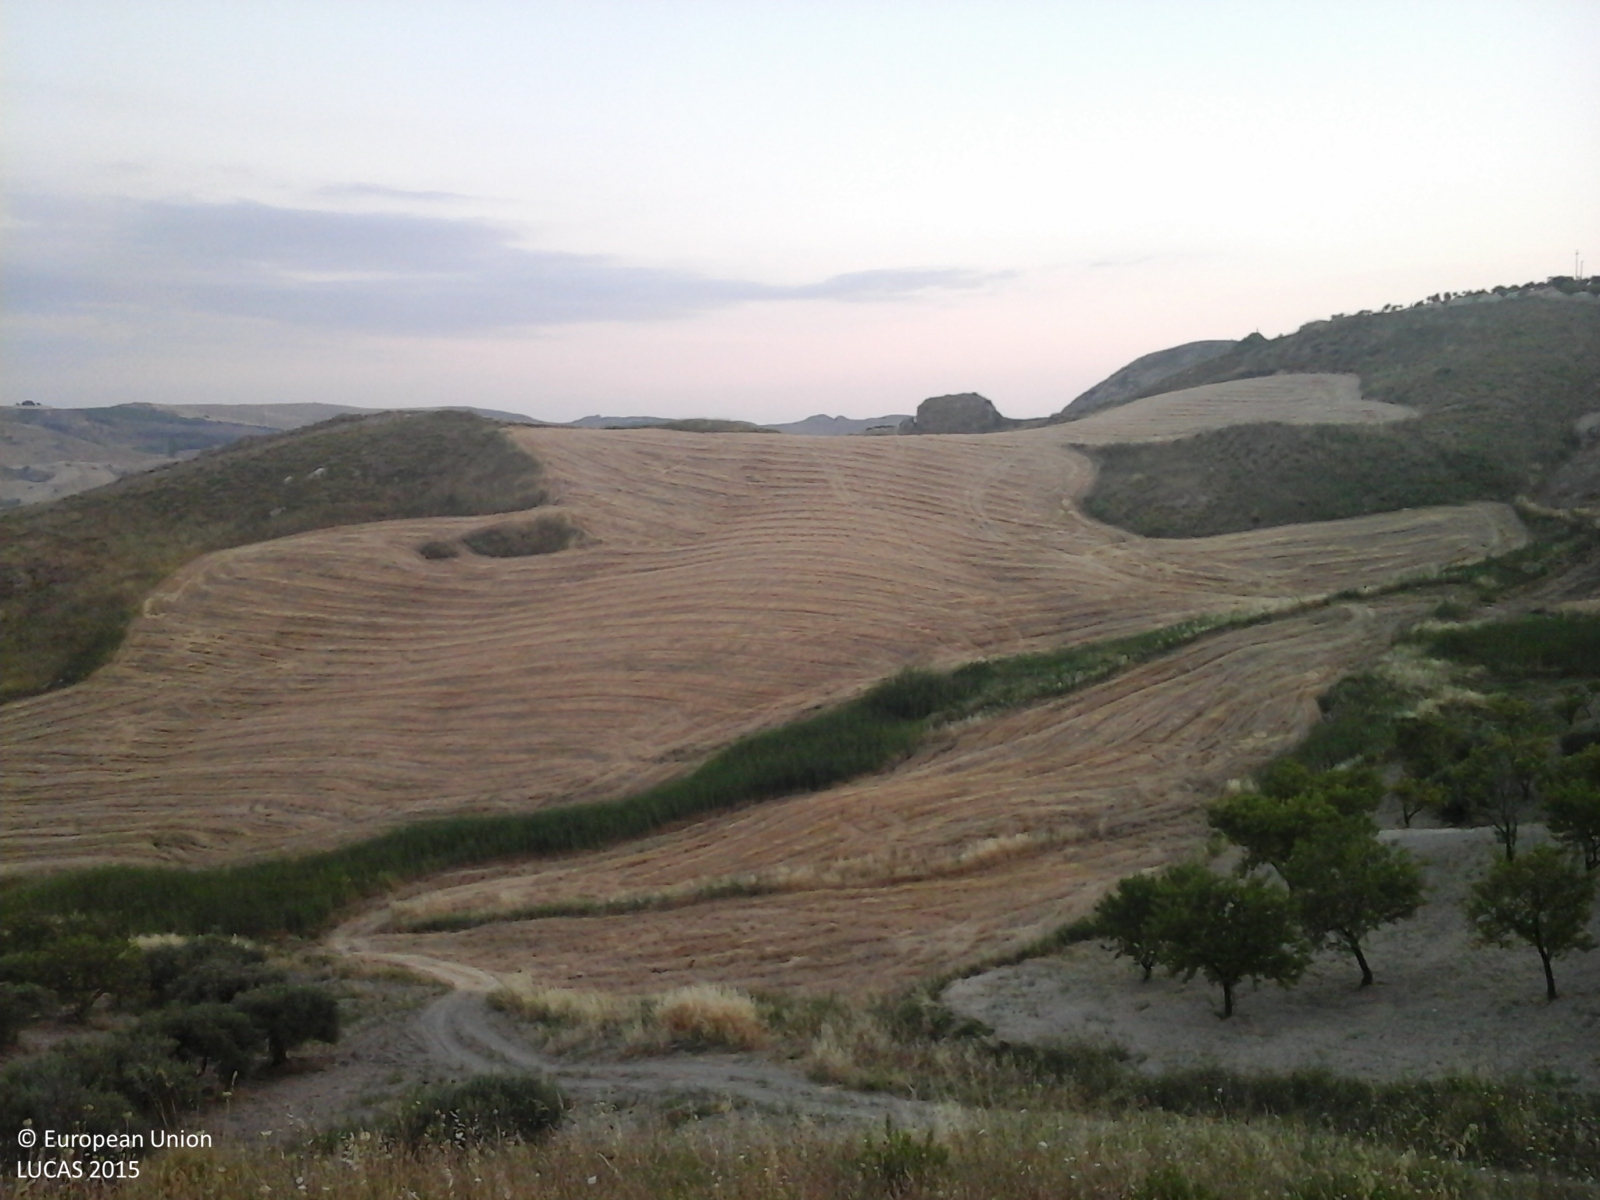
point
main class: Cropland
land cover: Durum wheat
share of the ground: > 75 %
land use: Agriculture (excluding fallow land and kitchen gardens)
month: July
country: IT
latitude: 37.5380
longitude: 13.4932
